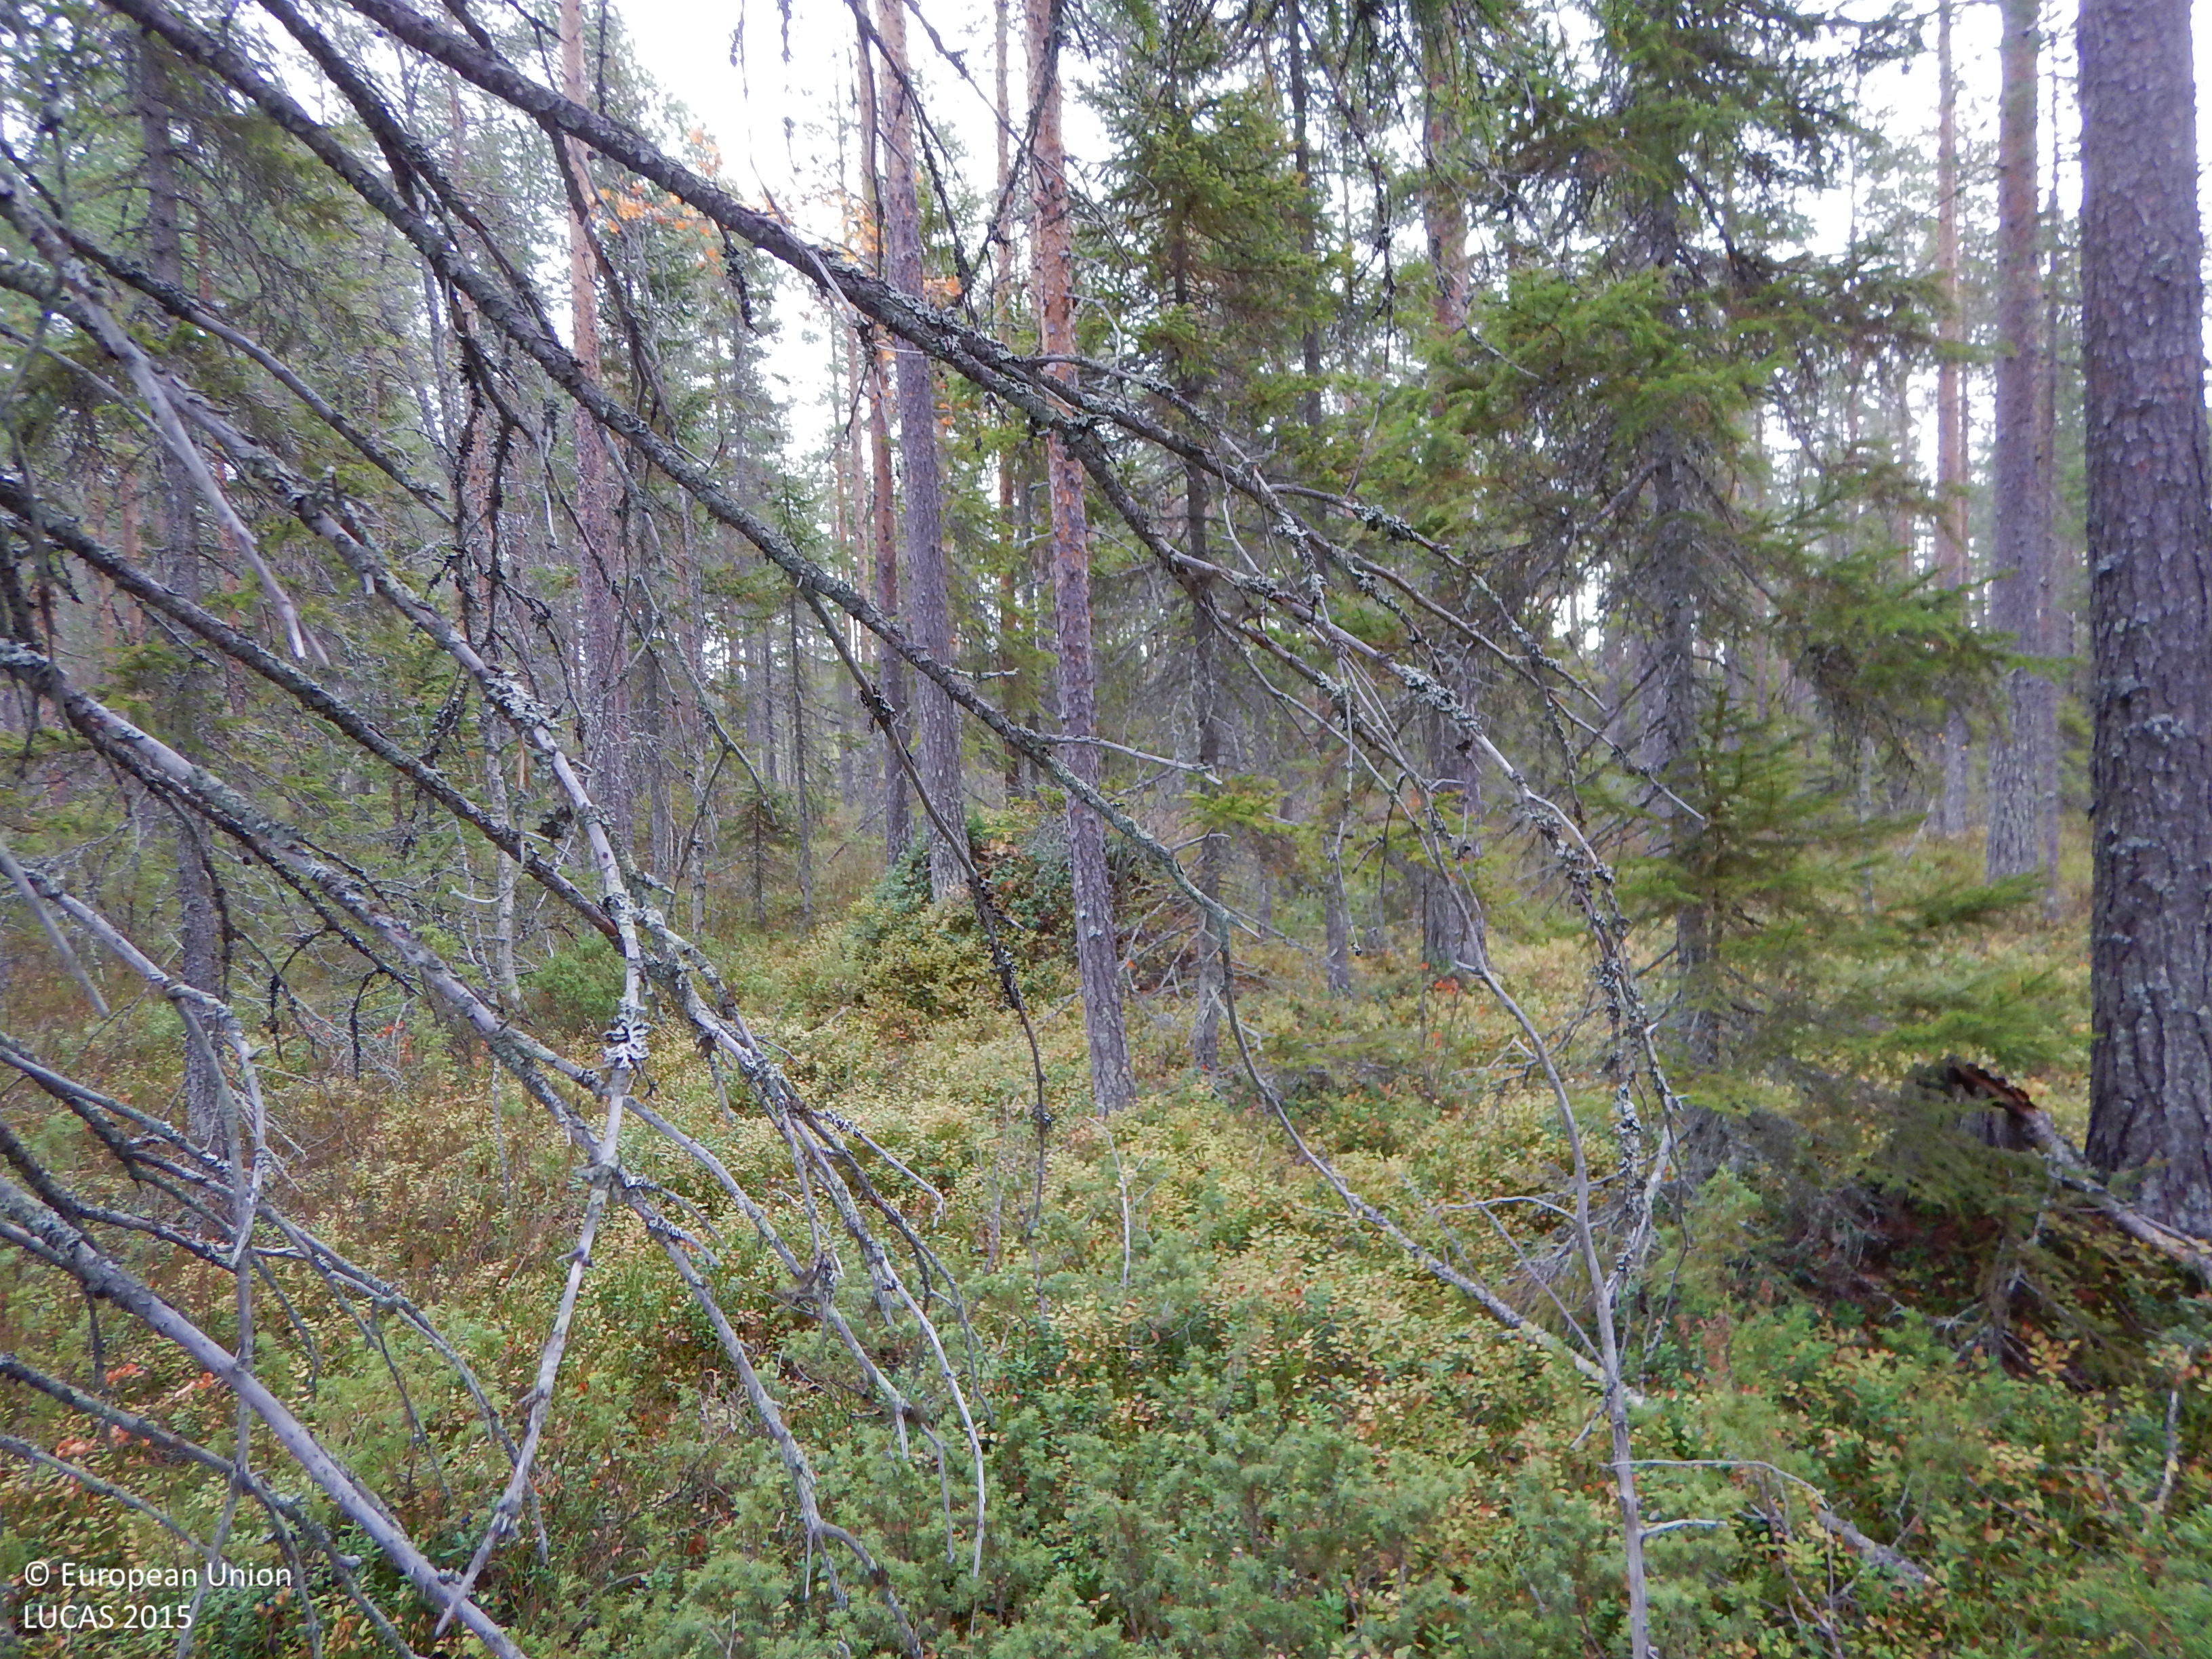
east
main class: Woodland
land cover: Other coniferous woodland
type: boreal forest
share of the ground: 50 - 75 %
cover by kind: coniferous forest trees 60 %, shrubs 20 %, herbaceous plants 10 %, lichens and mosses 10 %
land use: Forestry
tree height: > 5 m
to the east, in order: Other coniferous woodland; Pine dominated coniferous woodland
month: October
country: SE
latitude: 65.2077
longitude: 21.1957
